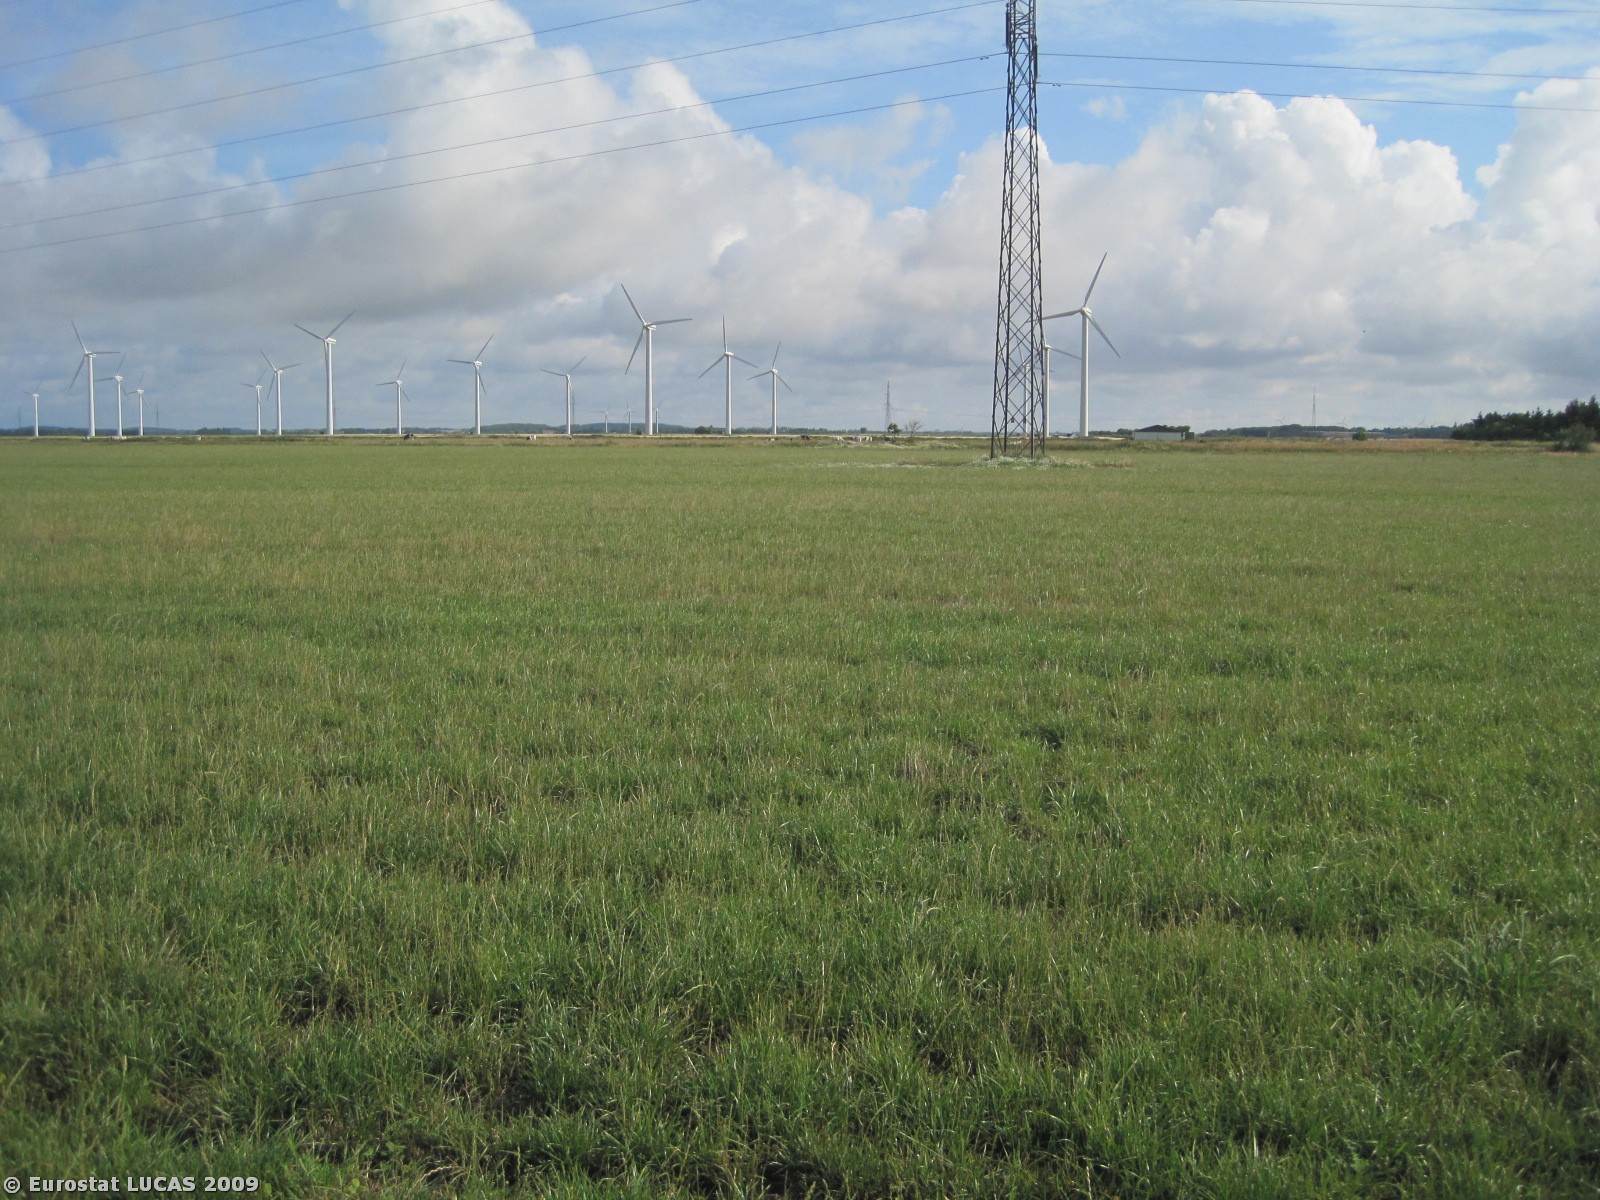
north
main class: Grassland
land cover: Grassland without tree/shrub cover
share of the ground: > 75 %
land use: Agriculture (excluding fallow land and kitchen gardens)
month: July
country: DK
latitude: 57.0480
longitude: 9.1606
